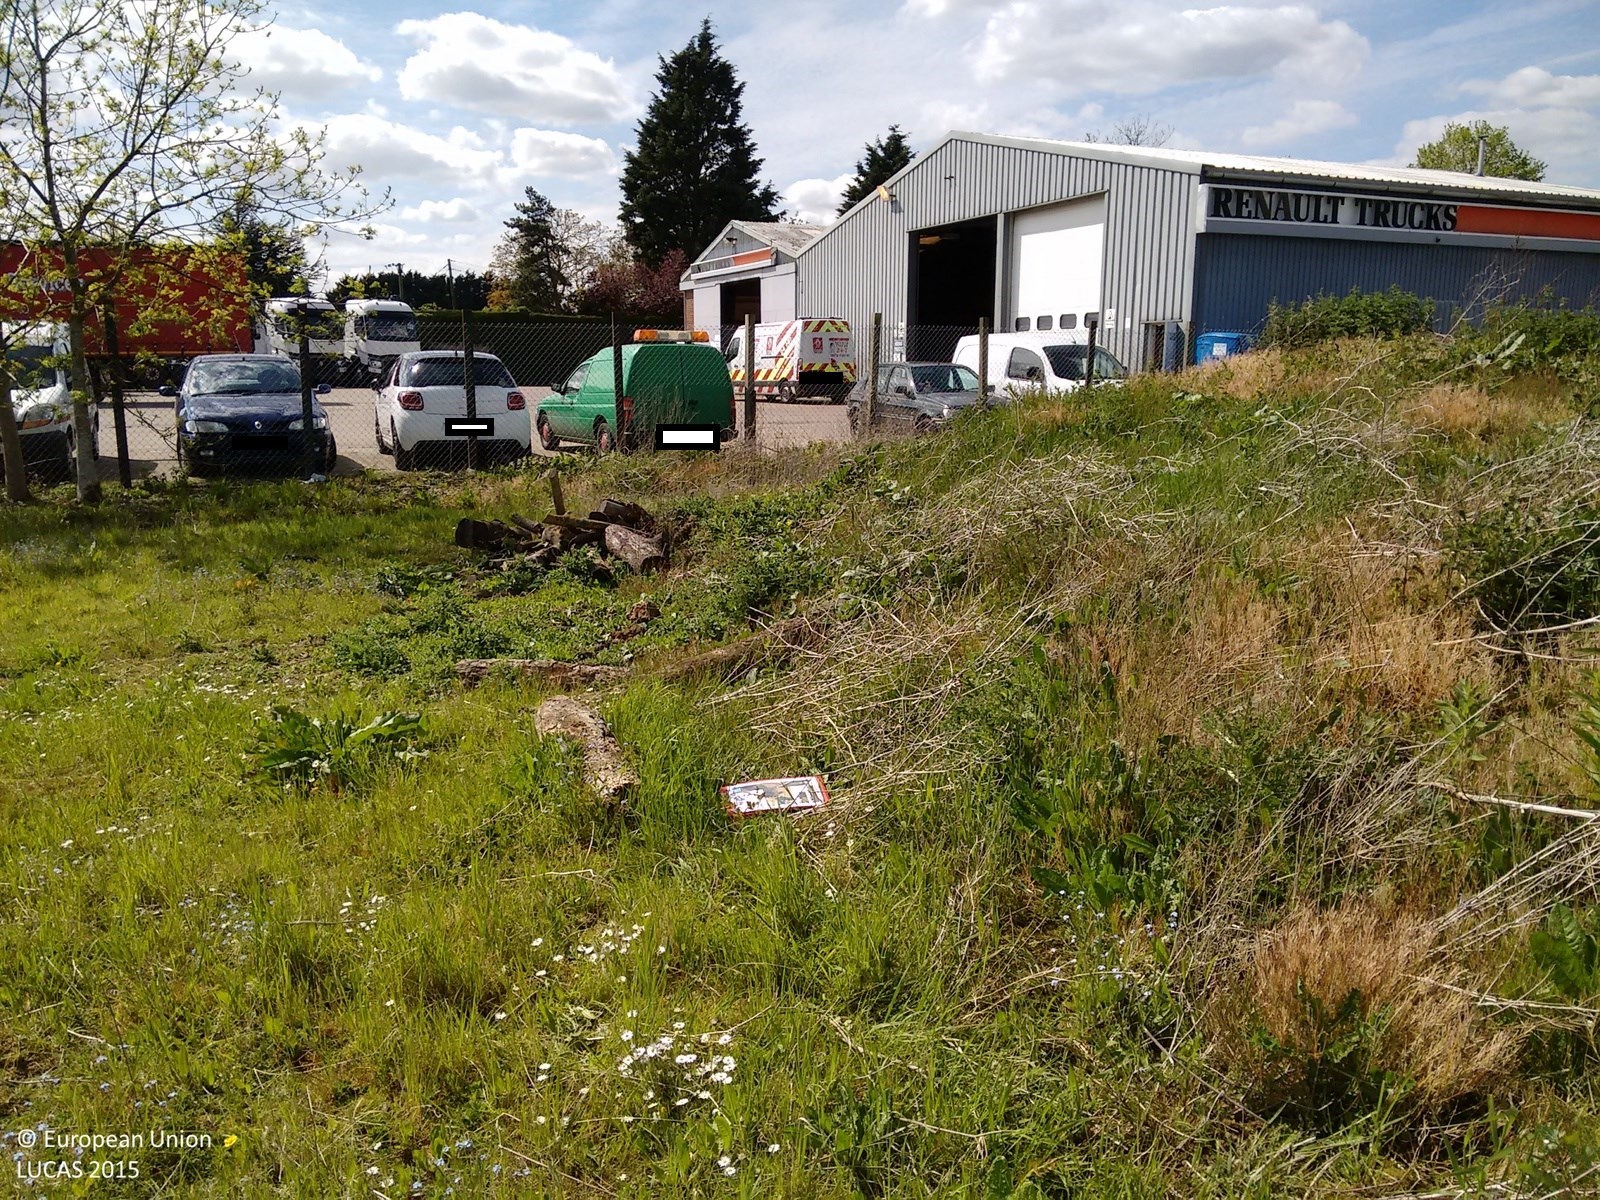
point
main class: Grassland
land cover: Grassland without tree/shrub cover
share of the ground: > 75 %
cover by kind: herbaceous plants 100 %
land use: Agriculture (excluding fallow land and kitchen gardens)
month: May
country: GB
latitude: 52.9570
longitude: -0.1412
